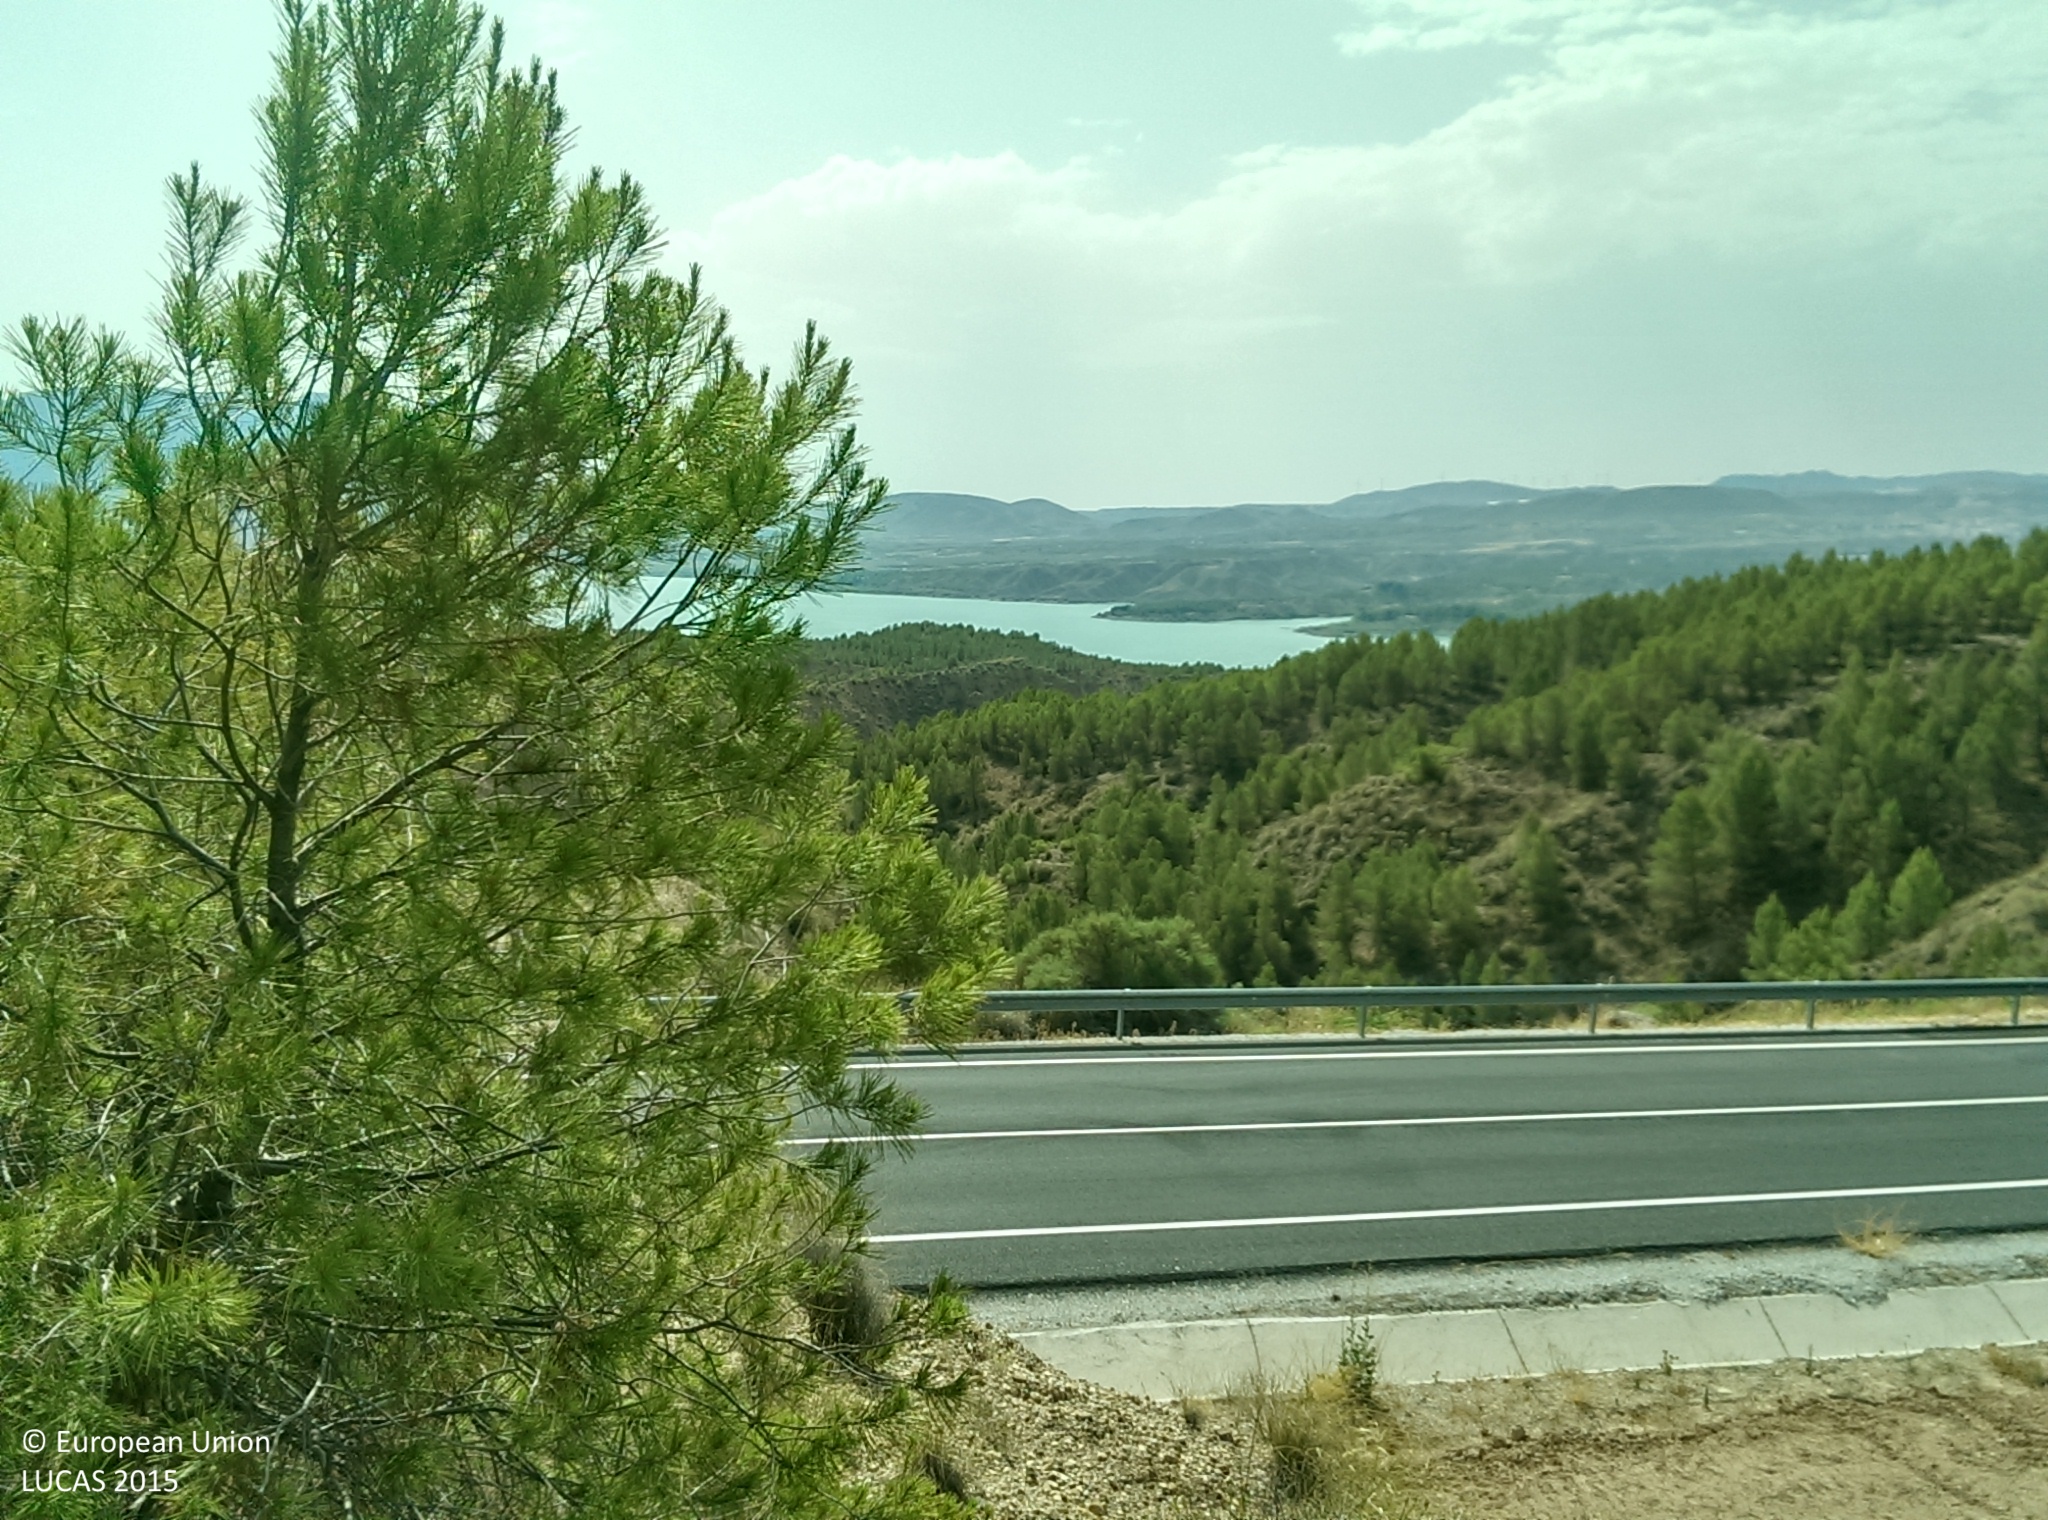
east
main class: Woodland
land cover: Pine dominated coniferous woodland
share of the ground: 50 - 75 %
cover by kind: coniferous forest trees 70 %, herbaceous plants 20 %, unconsolidated bare surface 10 %
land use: Forestry
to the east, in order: Pine dominated coniferous woodland; Other structural elements; Paved roads, cycling and walking lanes; Other structural elements; Shrubland with sparse tree cover; Pine dominated coniferous woodland; Shrubland with sparse tree cover; Shrubland without tree cover; Shrubland with sparse tree cover; Rivers and streams
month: July
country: ES
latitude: 37.5727
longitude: -2.9540
